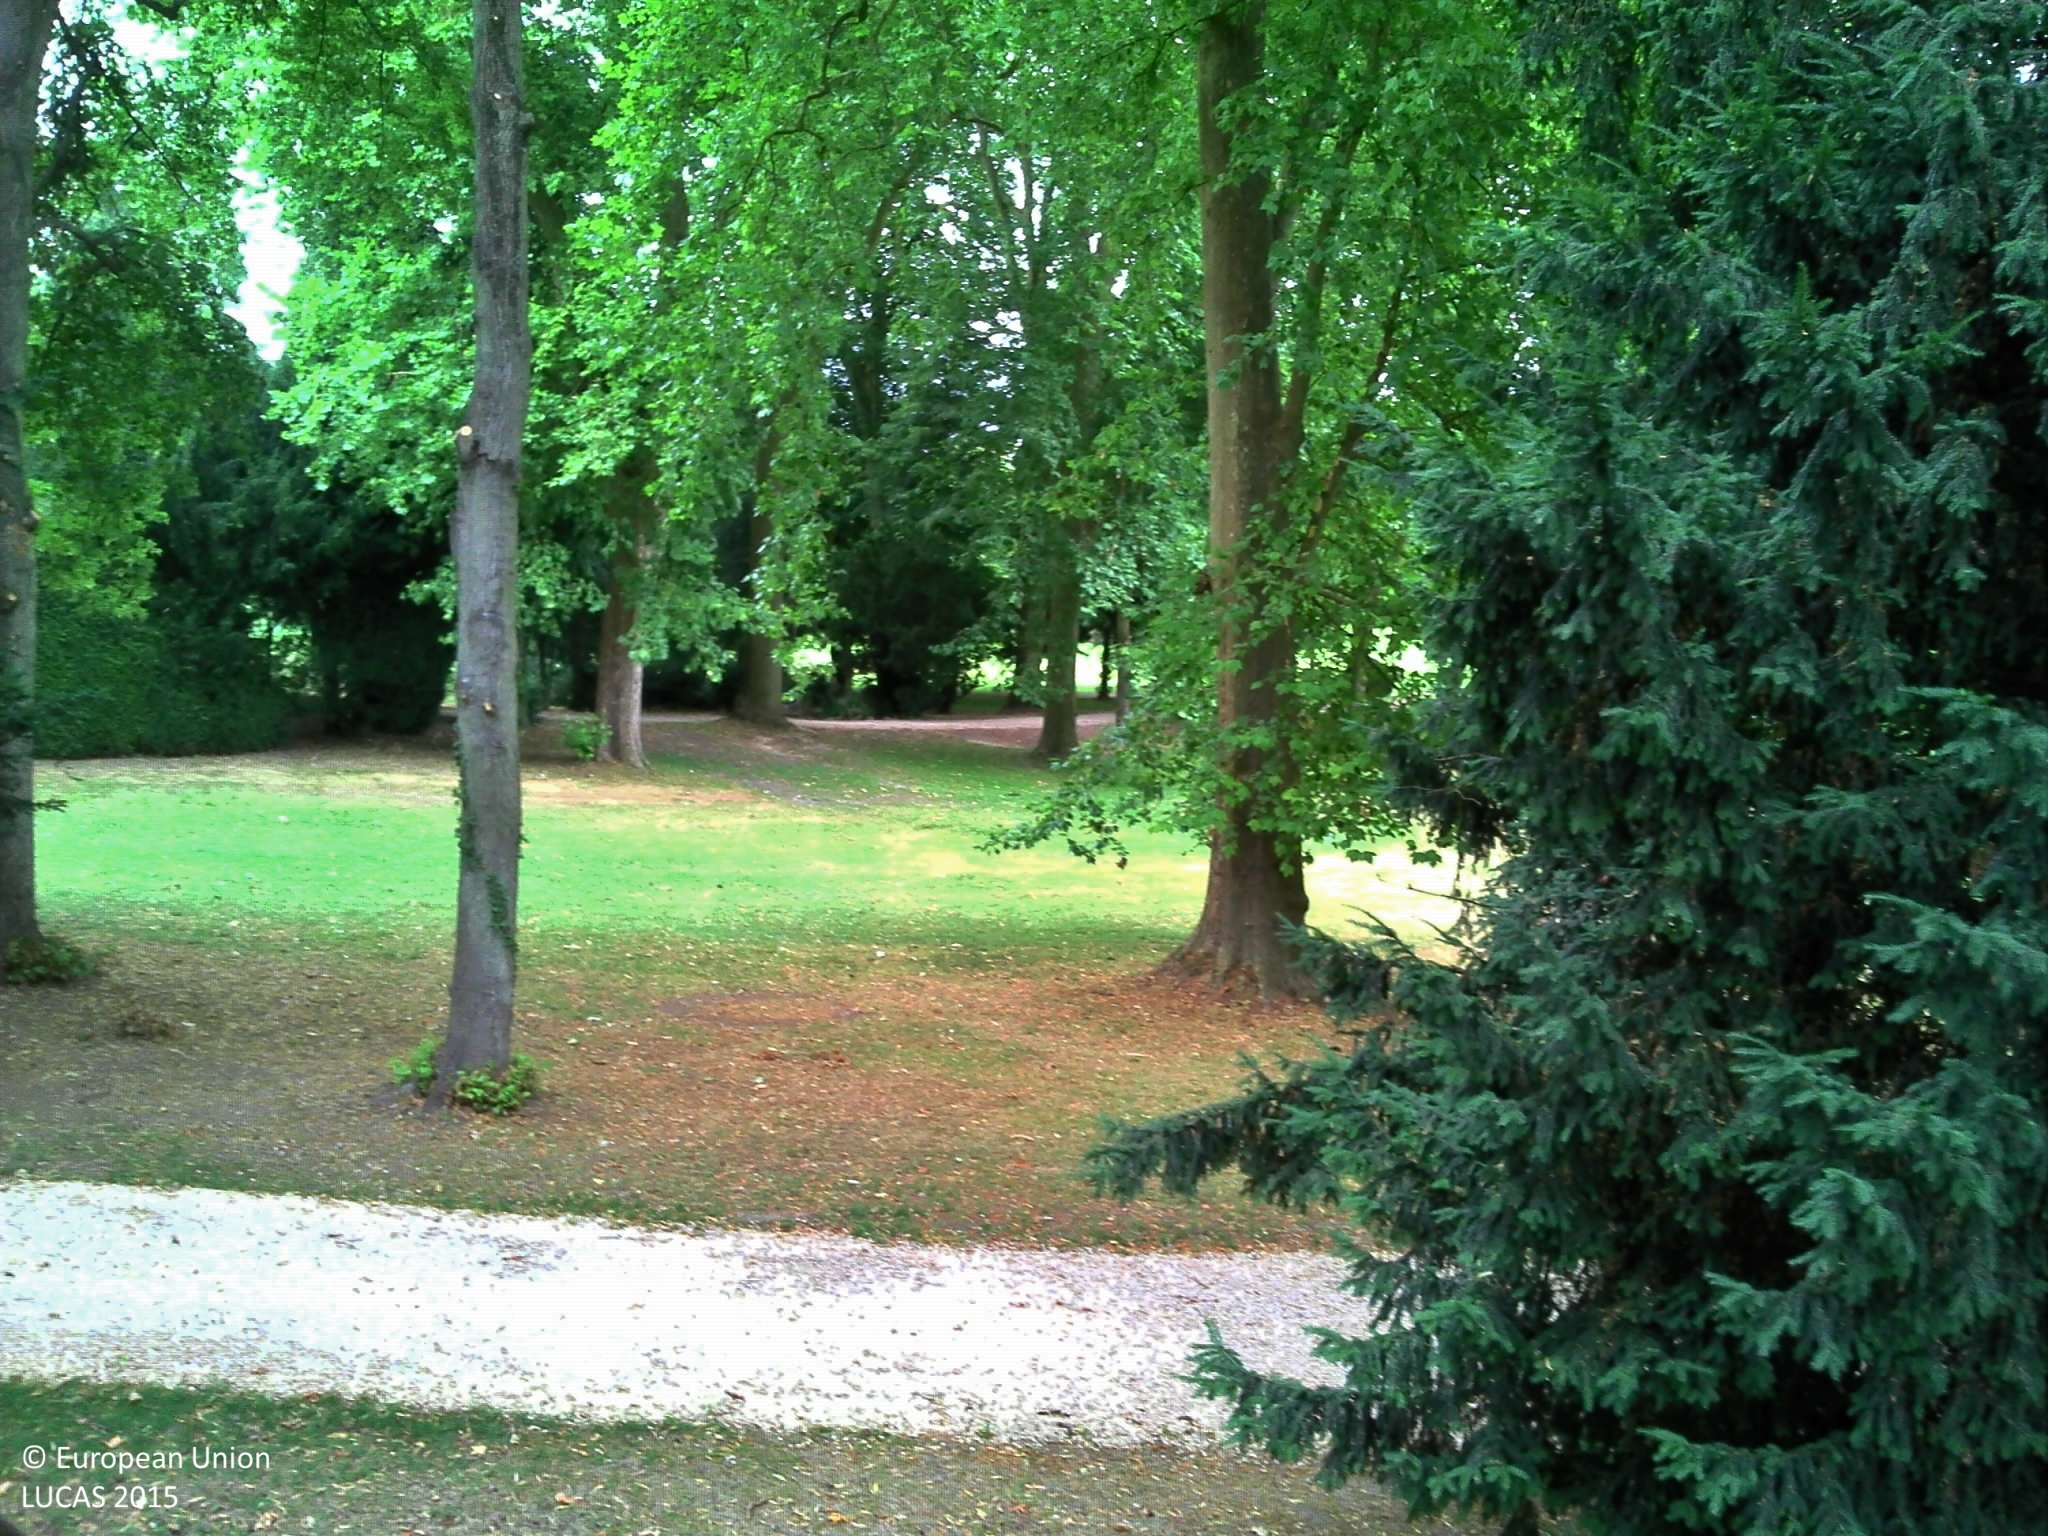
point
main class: Grassland
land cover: Grassland without tree/shrub cover
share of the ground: > 75 %
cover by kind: herbaceous plants 100 %
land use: Amenities, museums, leisure
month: July
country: FR
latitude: 49.1953
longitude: 2.4819
